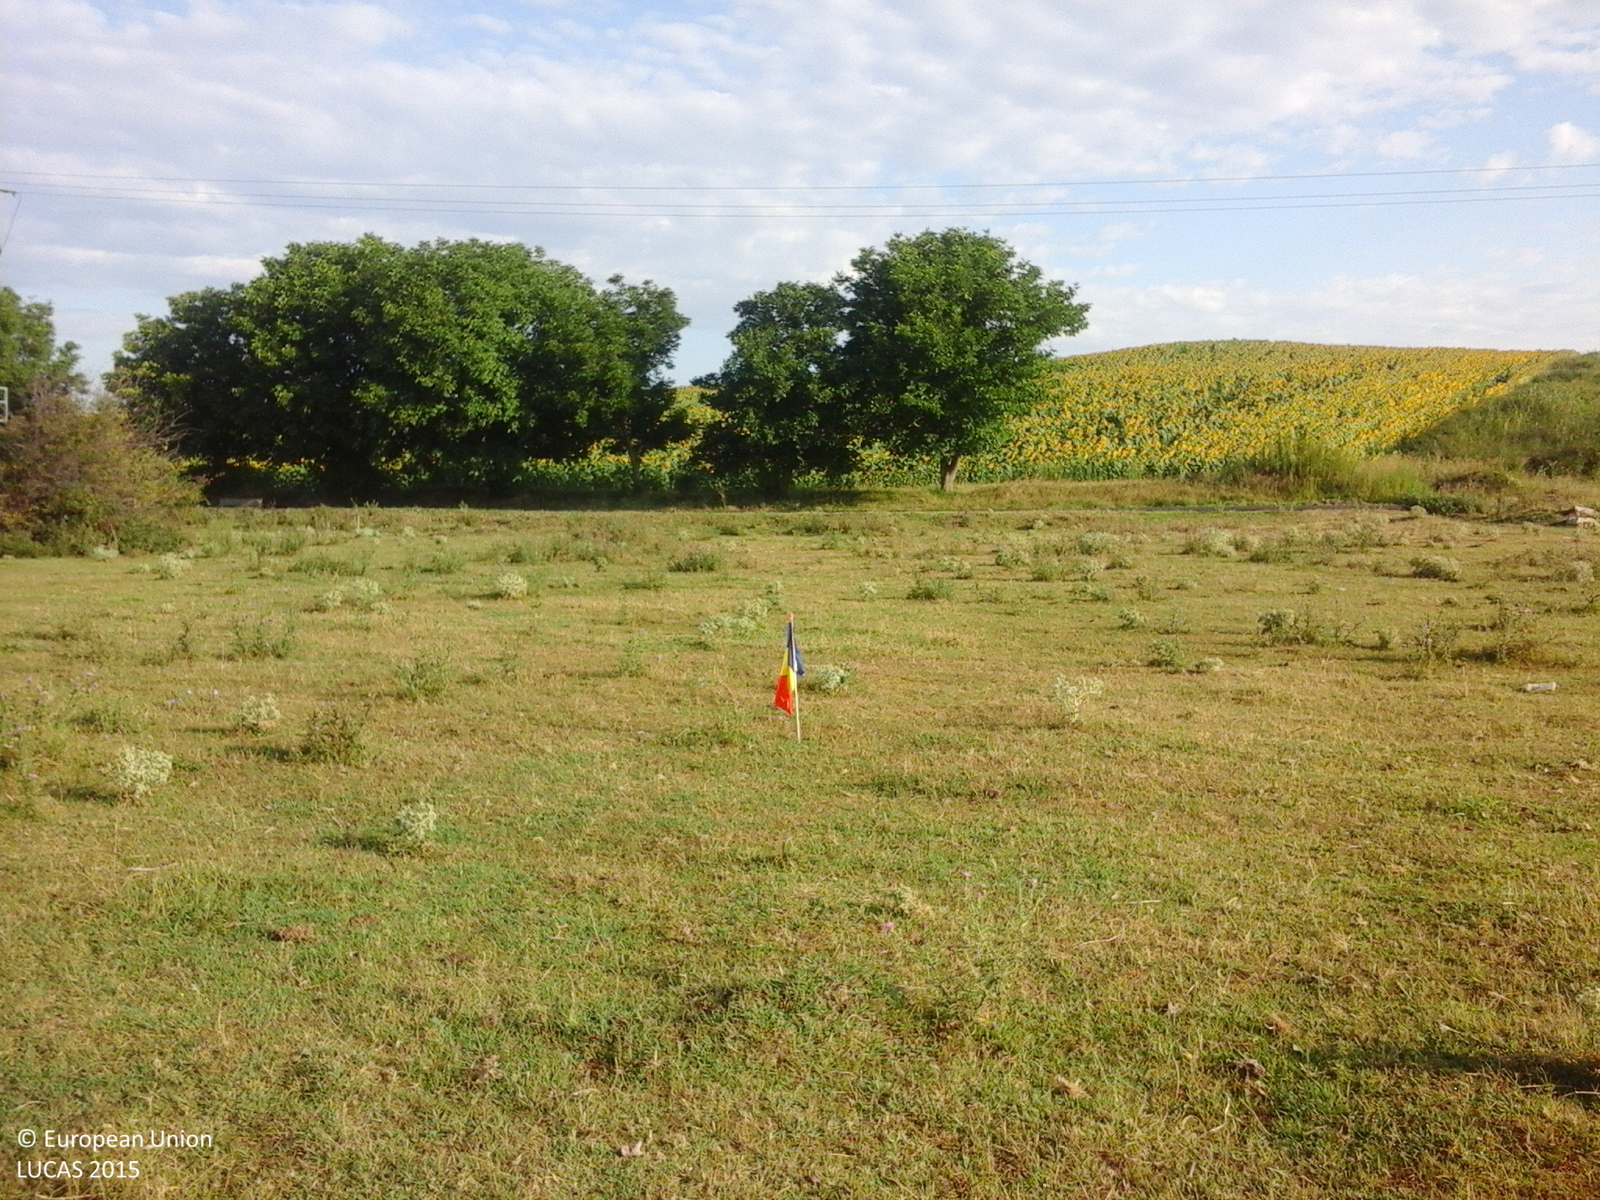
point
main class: Grassland
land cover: Grassland without tree/shrub cover
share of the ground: > 75 %
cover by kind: herbaceous plants 100 %
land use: Agriculture (excluding fallow land and kitchen gardens)
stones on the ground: < 10 %
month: July
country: RO
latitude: 46.1827
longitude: 27.7210
